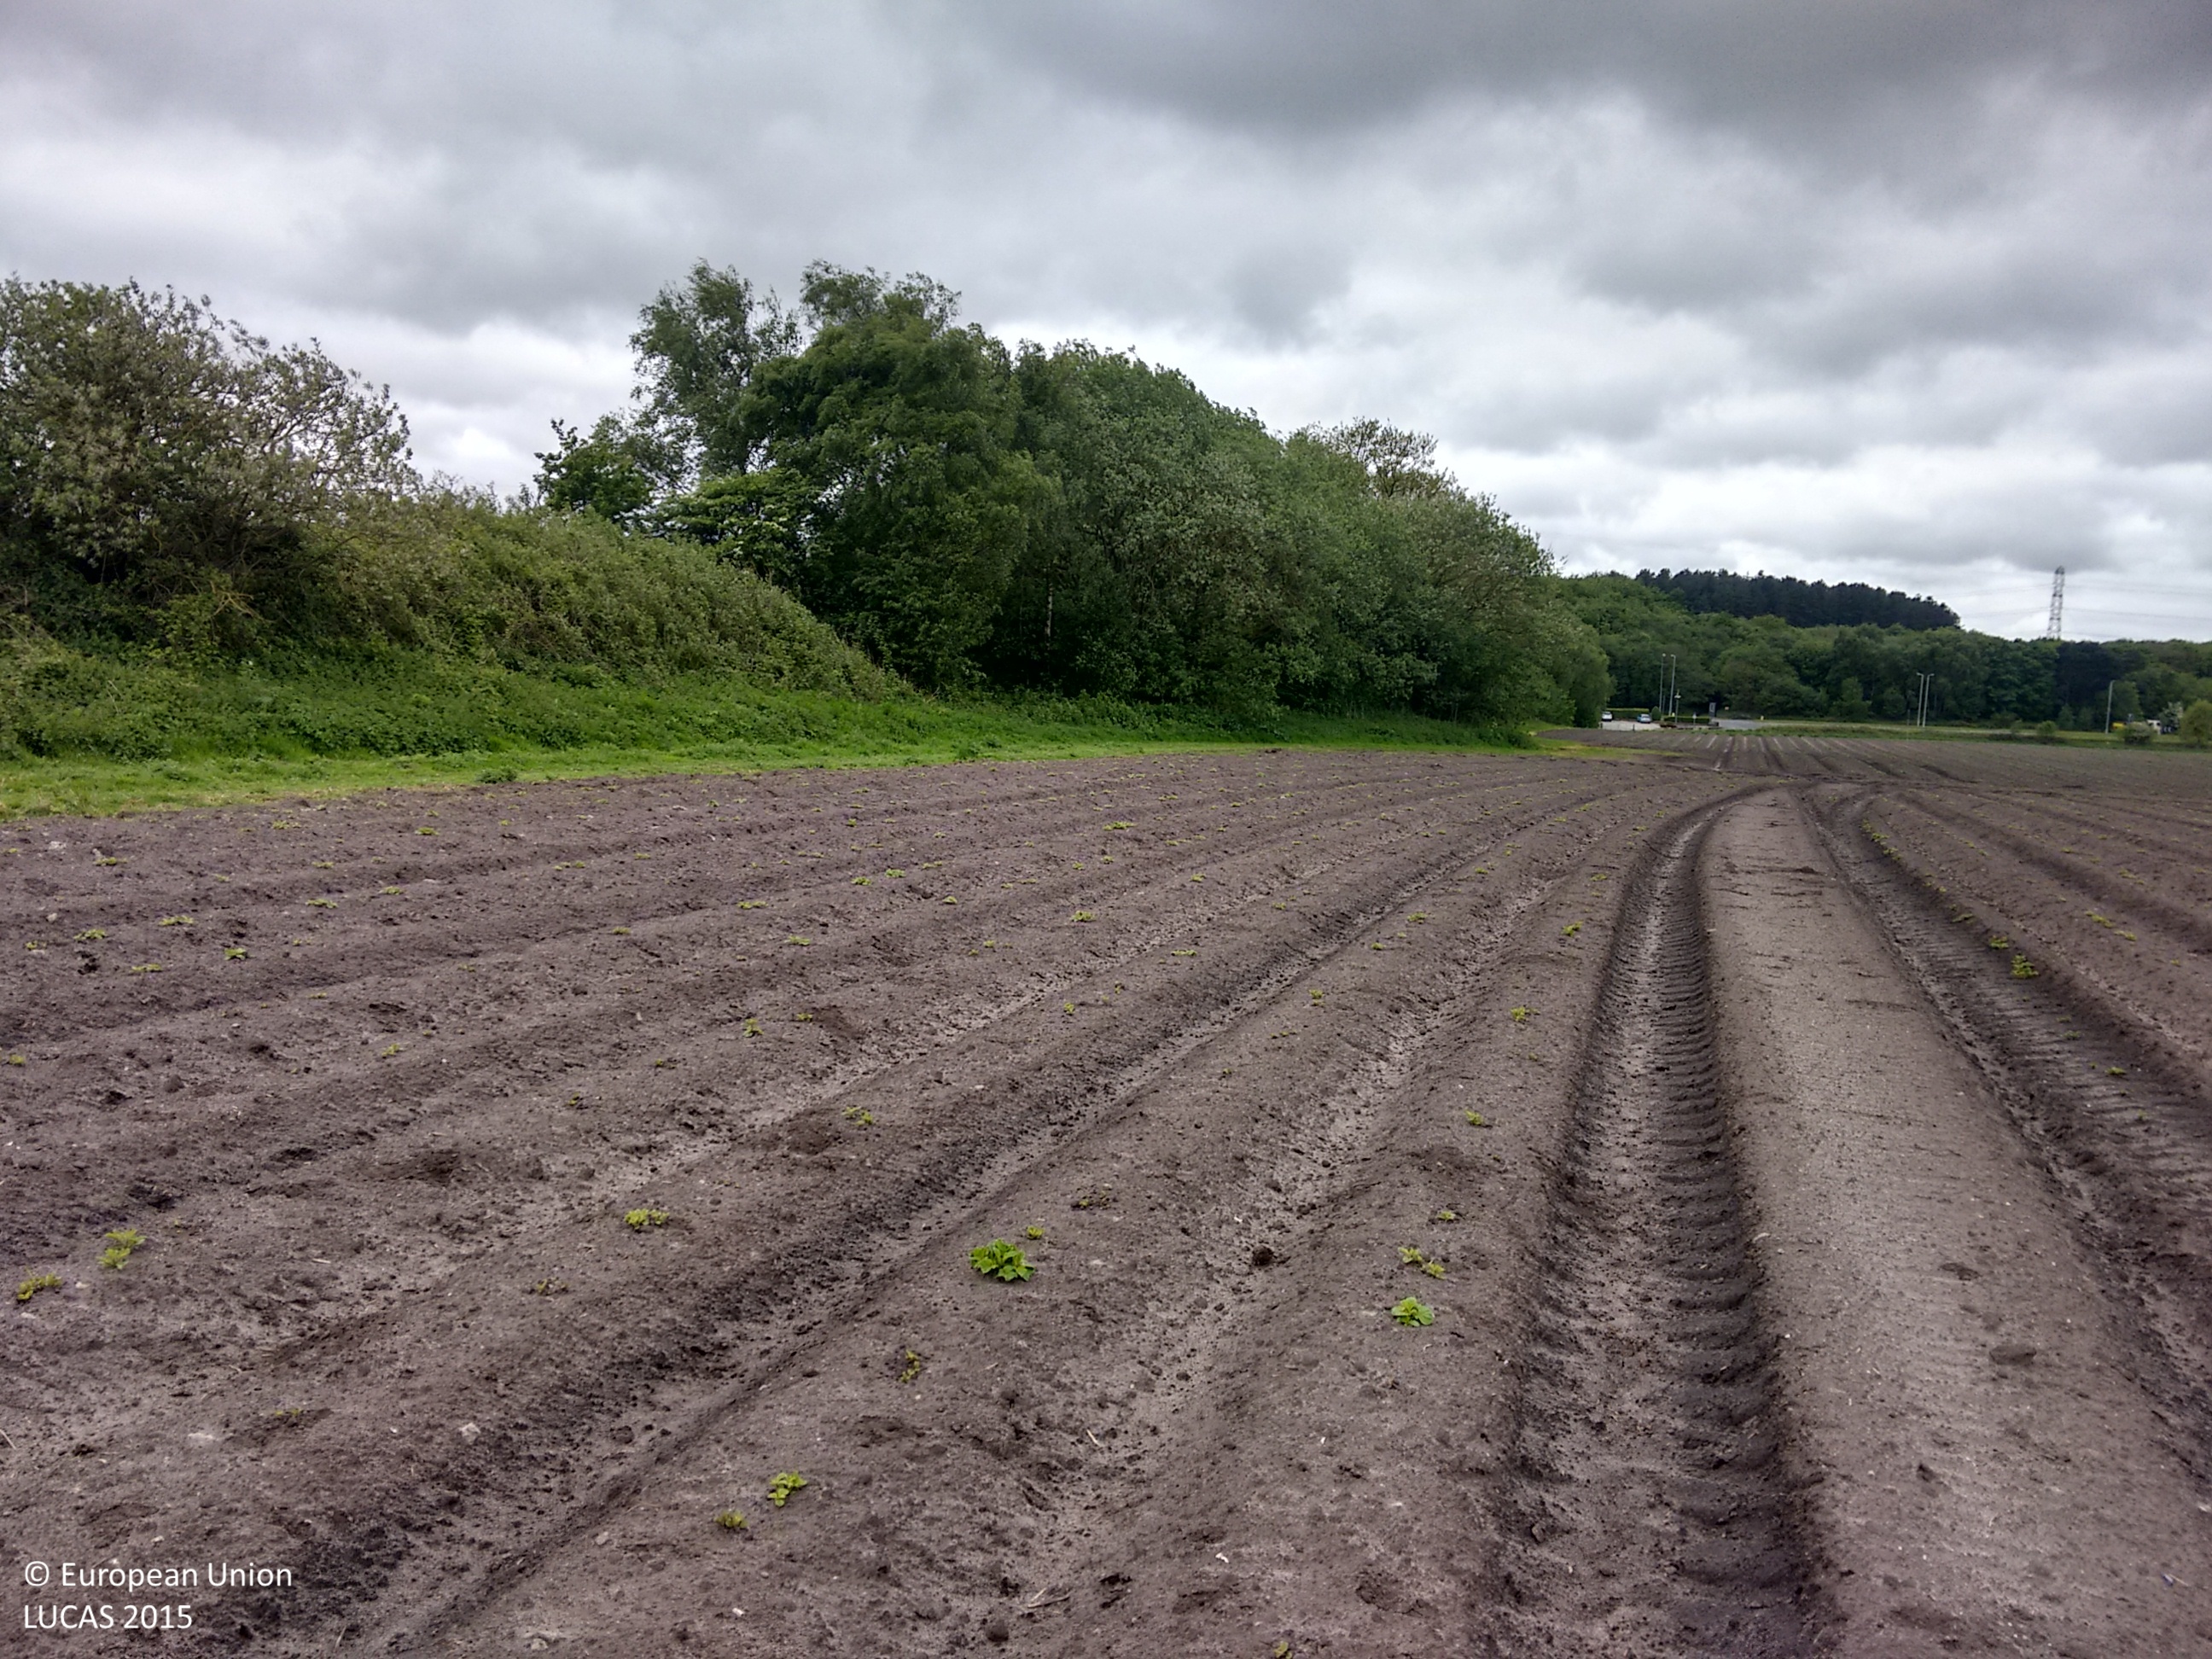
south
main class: Cropland
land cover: Potatoes
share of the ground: < 10 %
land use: Agriculture (excluding fallow land and kitchen gardens)
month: May
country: GB
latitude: 53.5366
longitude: -2.8207
